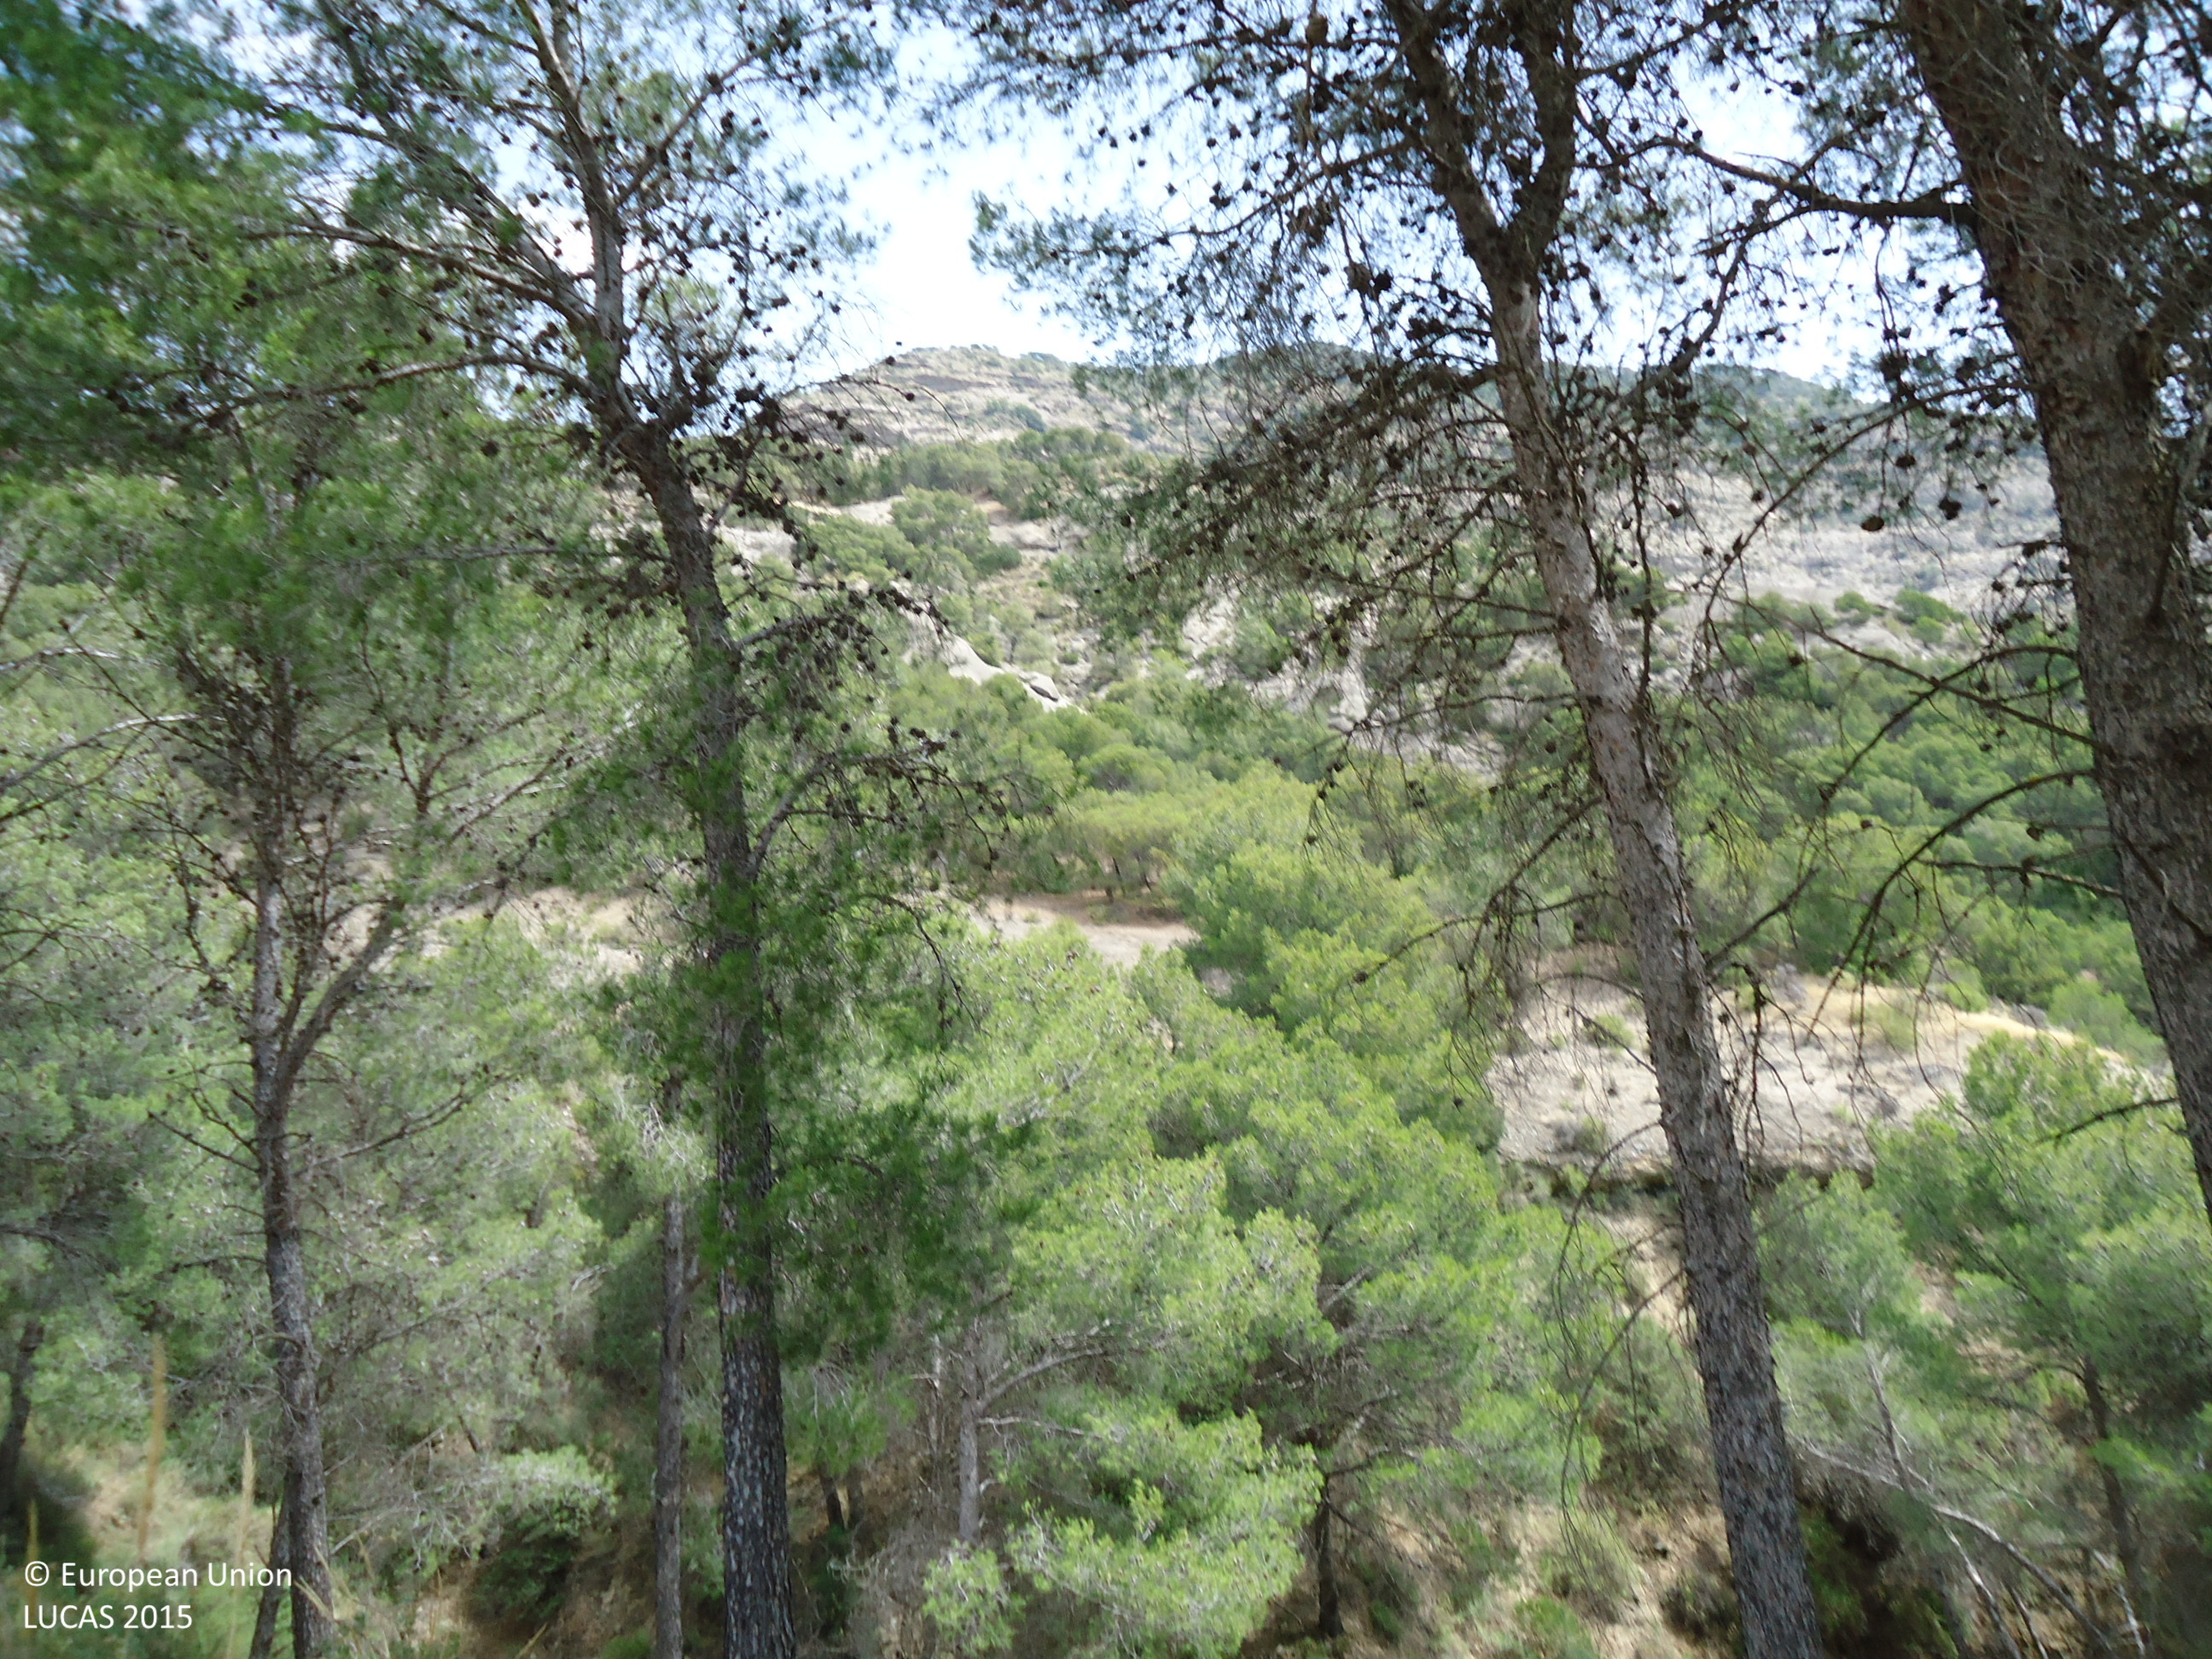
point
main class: Woodland
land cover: Pine dominated coniferous woodland
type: coniferous forest of the mediterranean region
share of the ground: > 75 %
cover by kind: coniferous forest trees 75 %, consolidated bare surface 20 %, shrubs 5 %
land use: Forestry
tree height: > 5 m
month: June
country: ES
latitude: 36.9134
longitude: -4.8026
